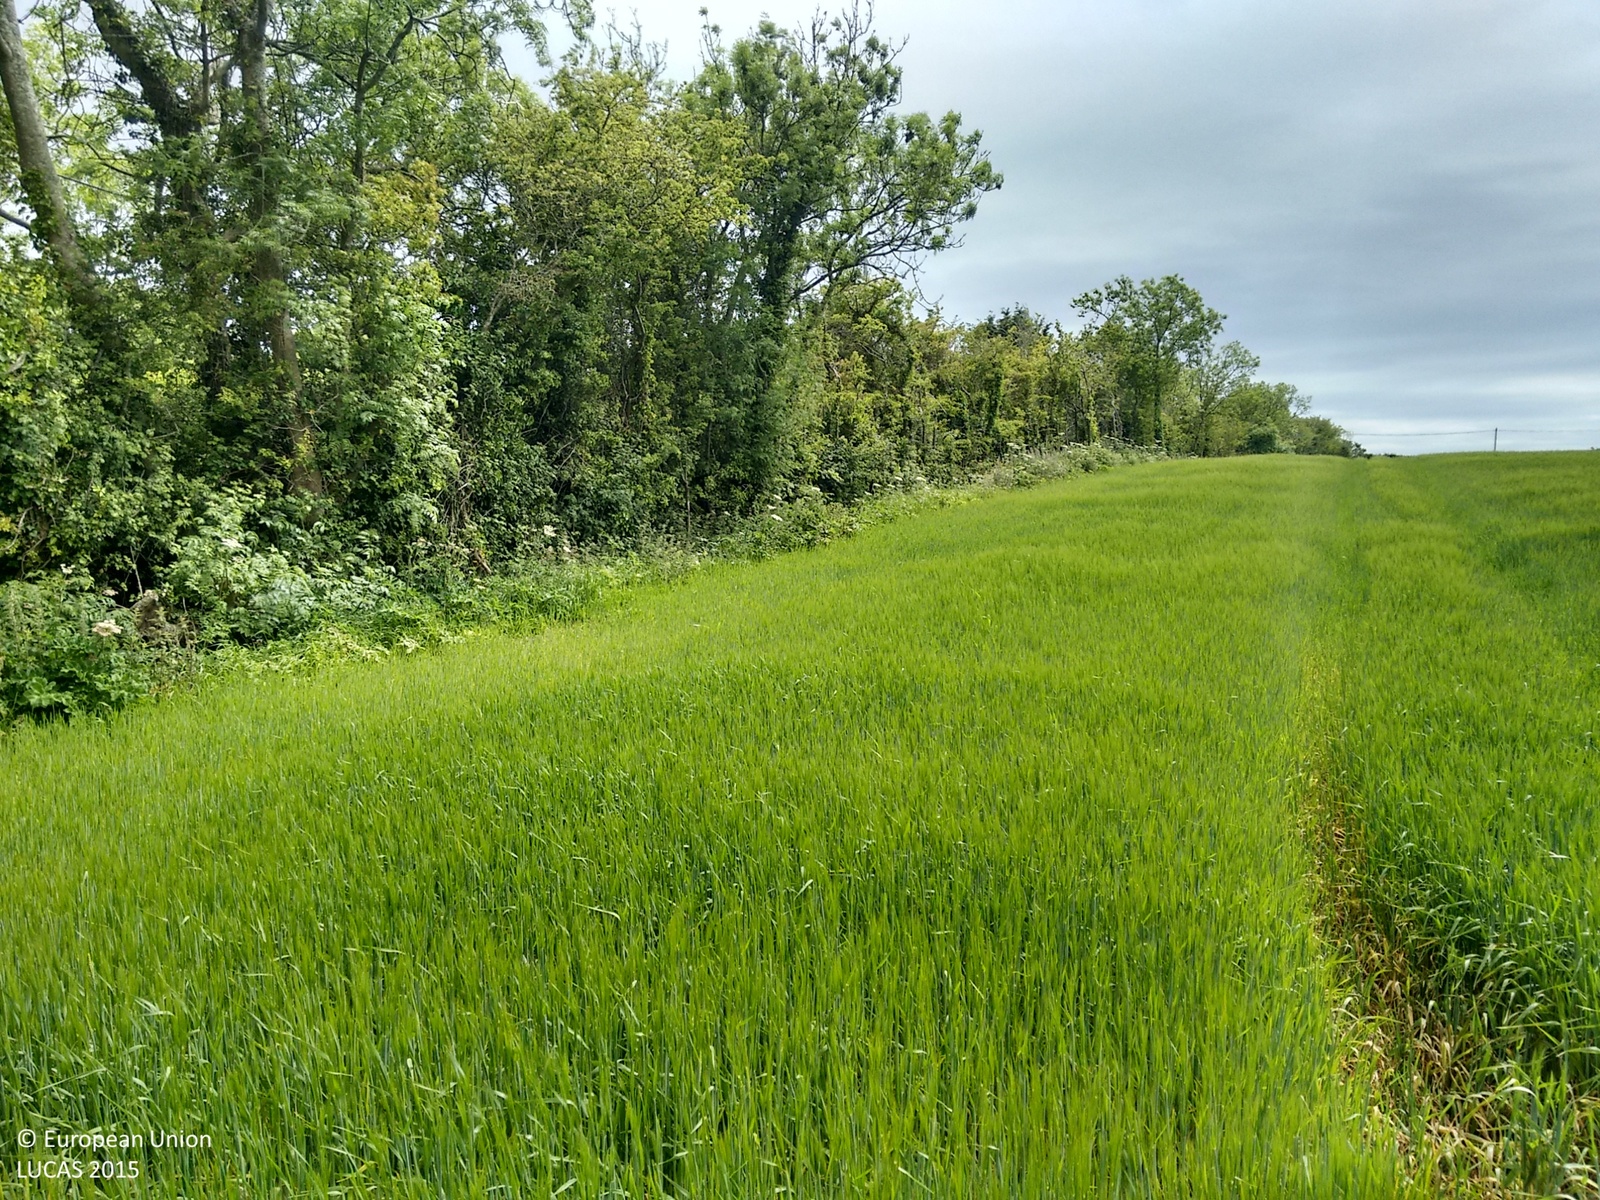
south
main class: Cropland
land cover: Common wheat
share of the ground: > 75 %
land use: Agriculture (excluding fallow land and kitchen gardens)
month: June
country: IE
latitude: 53.5369
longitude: -6.1557
